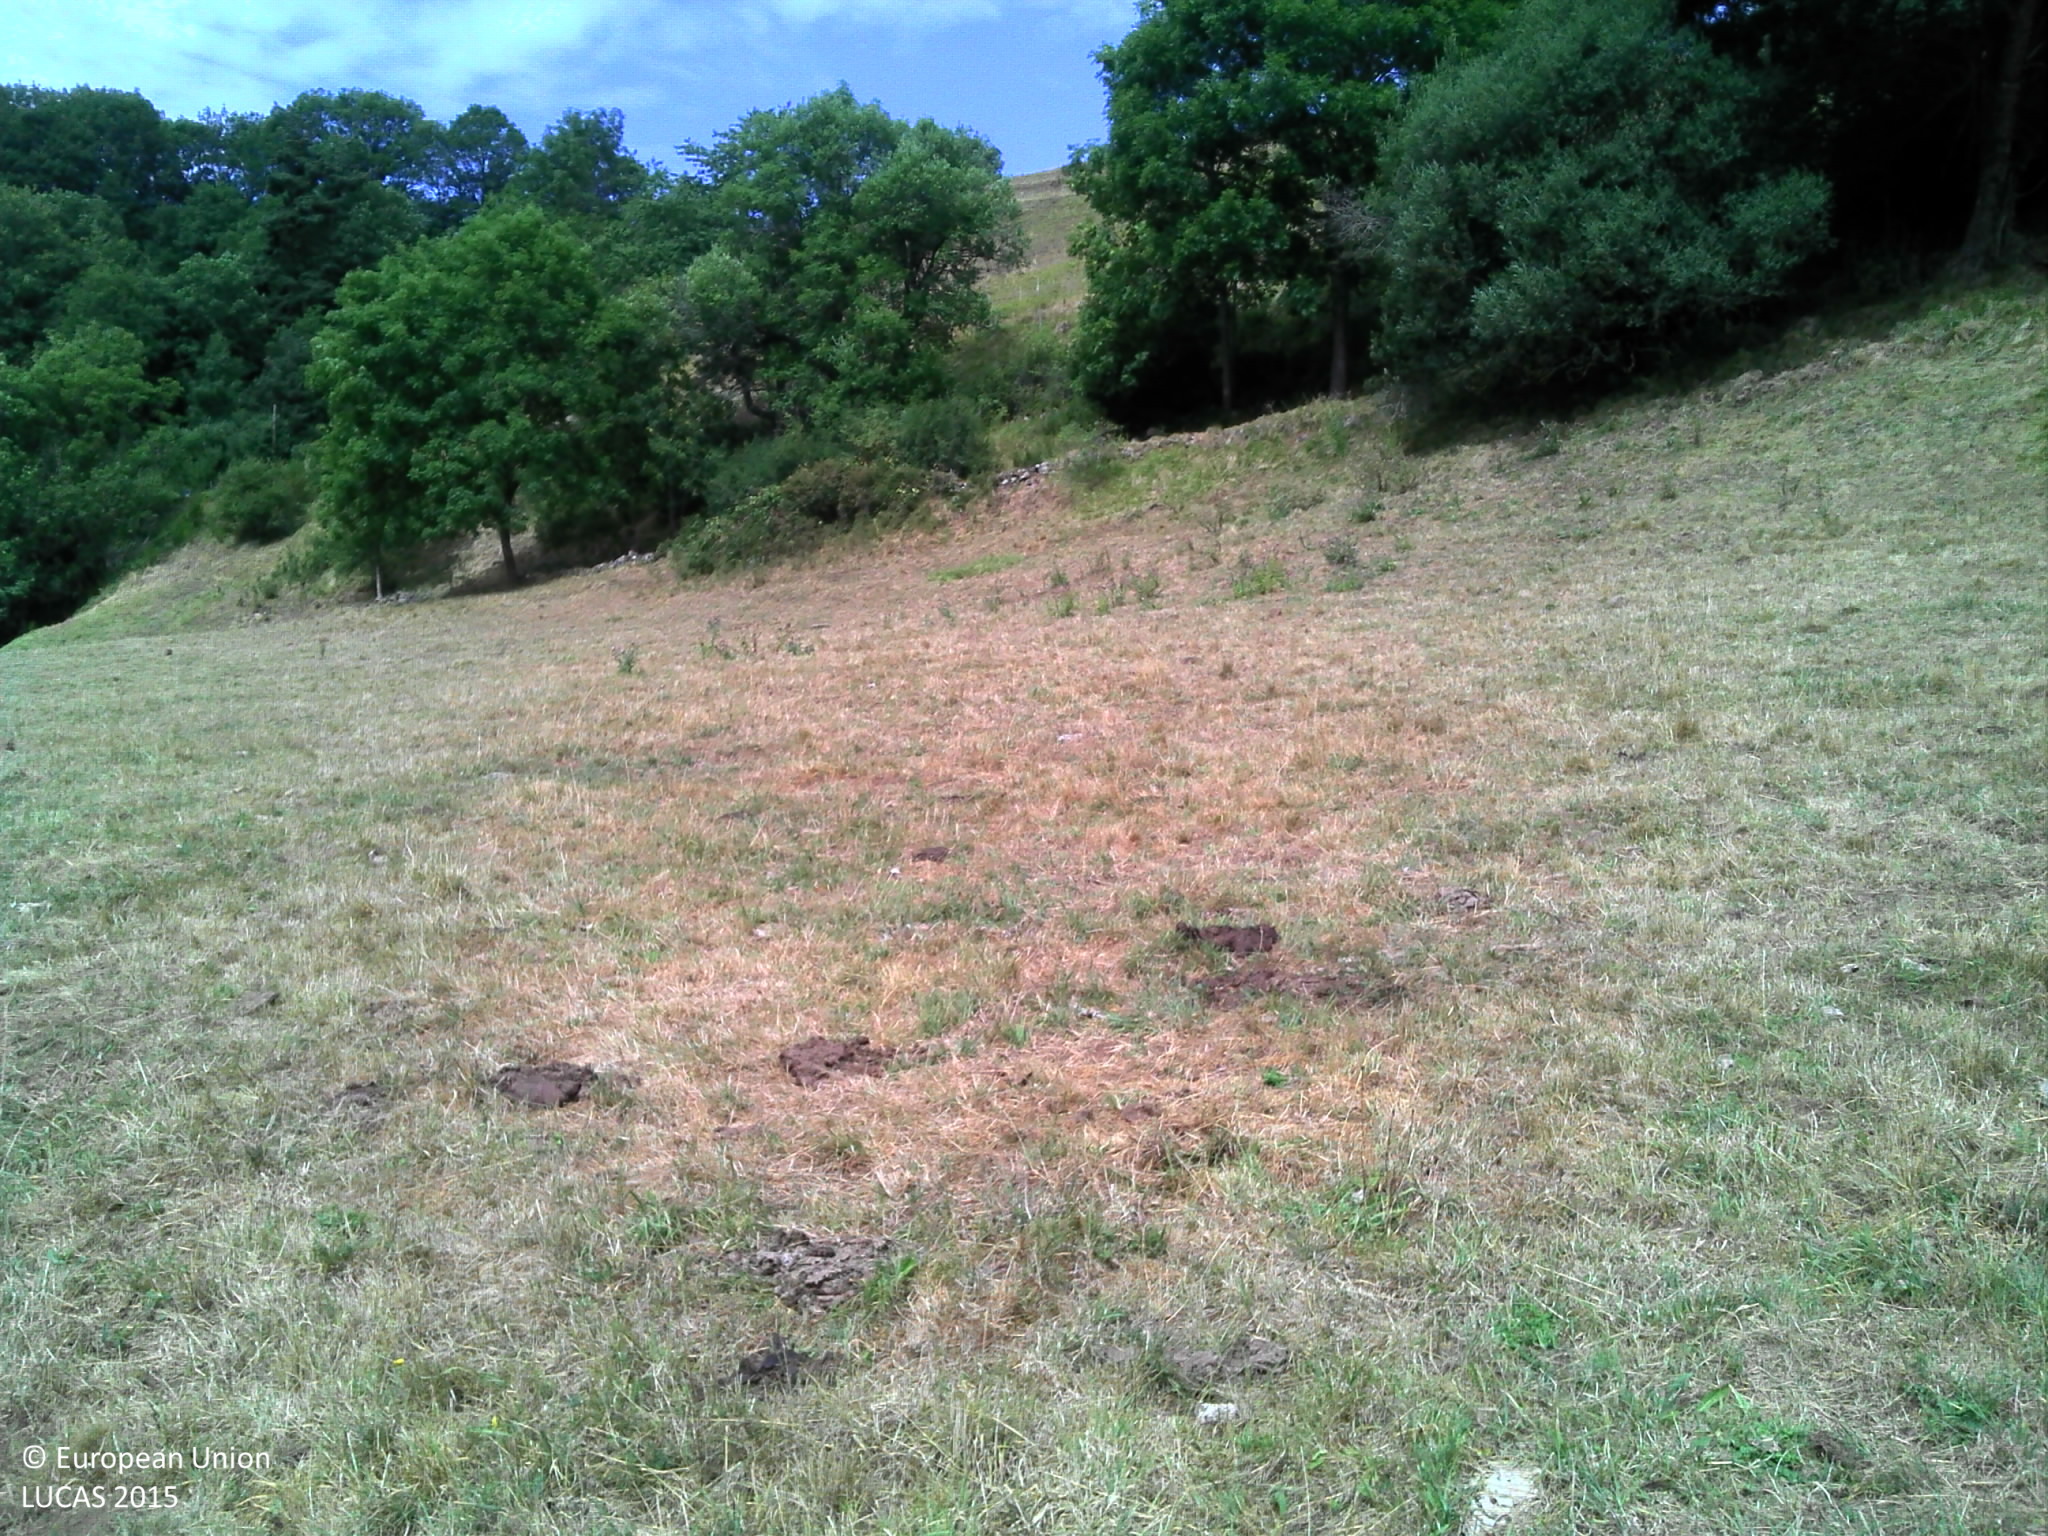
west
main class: Grassland
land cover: Grassland without tree/shrub cover
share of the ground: > 75 %
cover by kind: herbaceous plants 100 %
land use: Agriculture (excluding fallow land and kitchen gardens)
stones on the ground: < 10 %
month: July
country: FR
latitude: 44.7319
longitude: 3.9063
